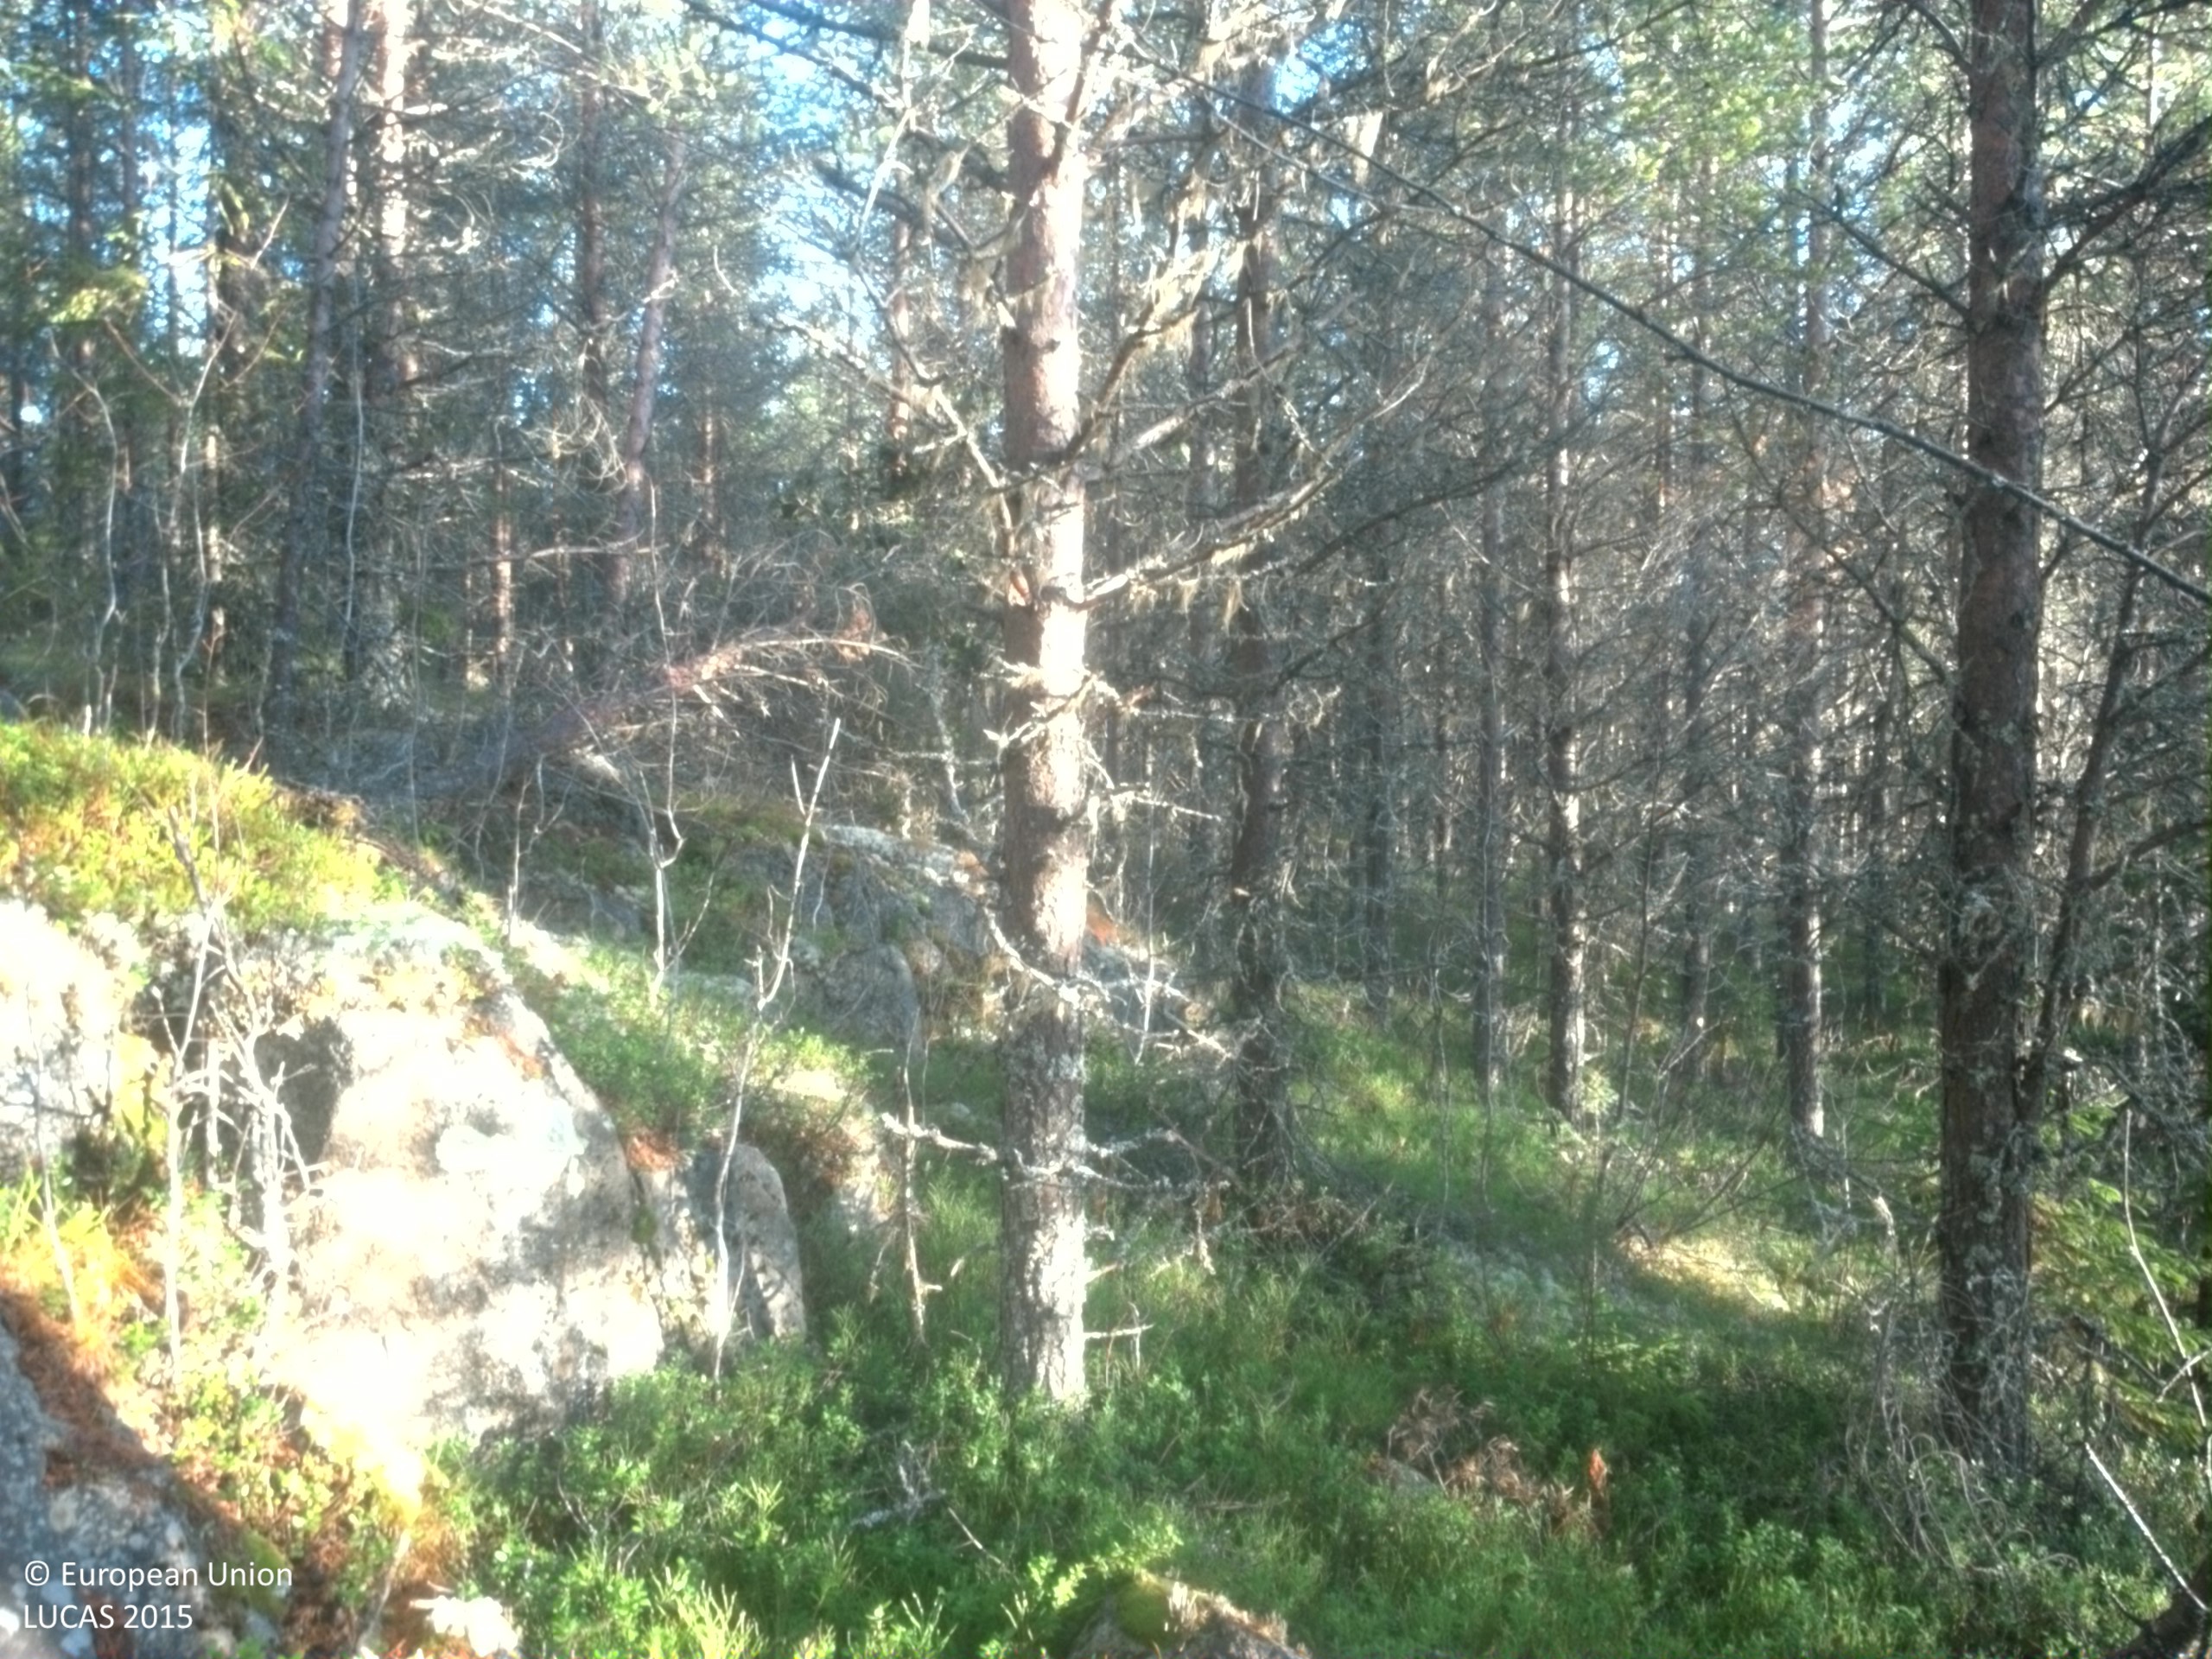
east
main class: Woodland
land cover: Pine dominated coniferous woodland
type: boreal forest
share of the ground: 50 - 75 %
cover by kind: coniferous forest trees 45 %, shrubs 30 %, lichens and mosses 15 %, broadleaved forest trees 5 %, consolidated bare surface 5 %
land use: Forestry
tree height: > 5 m
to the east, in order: Pine dominated coniferous woodland; Spruce dominated mixed woodland
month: November
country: SE
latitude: 63.9604
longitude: 15.9541
